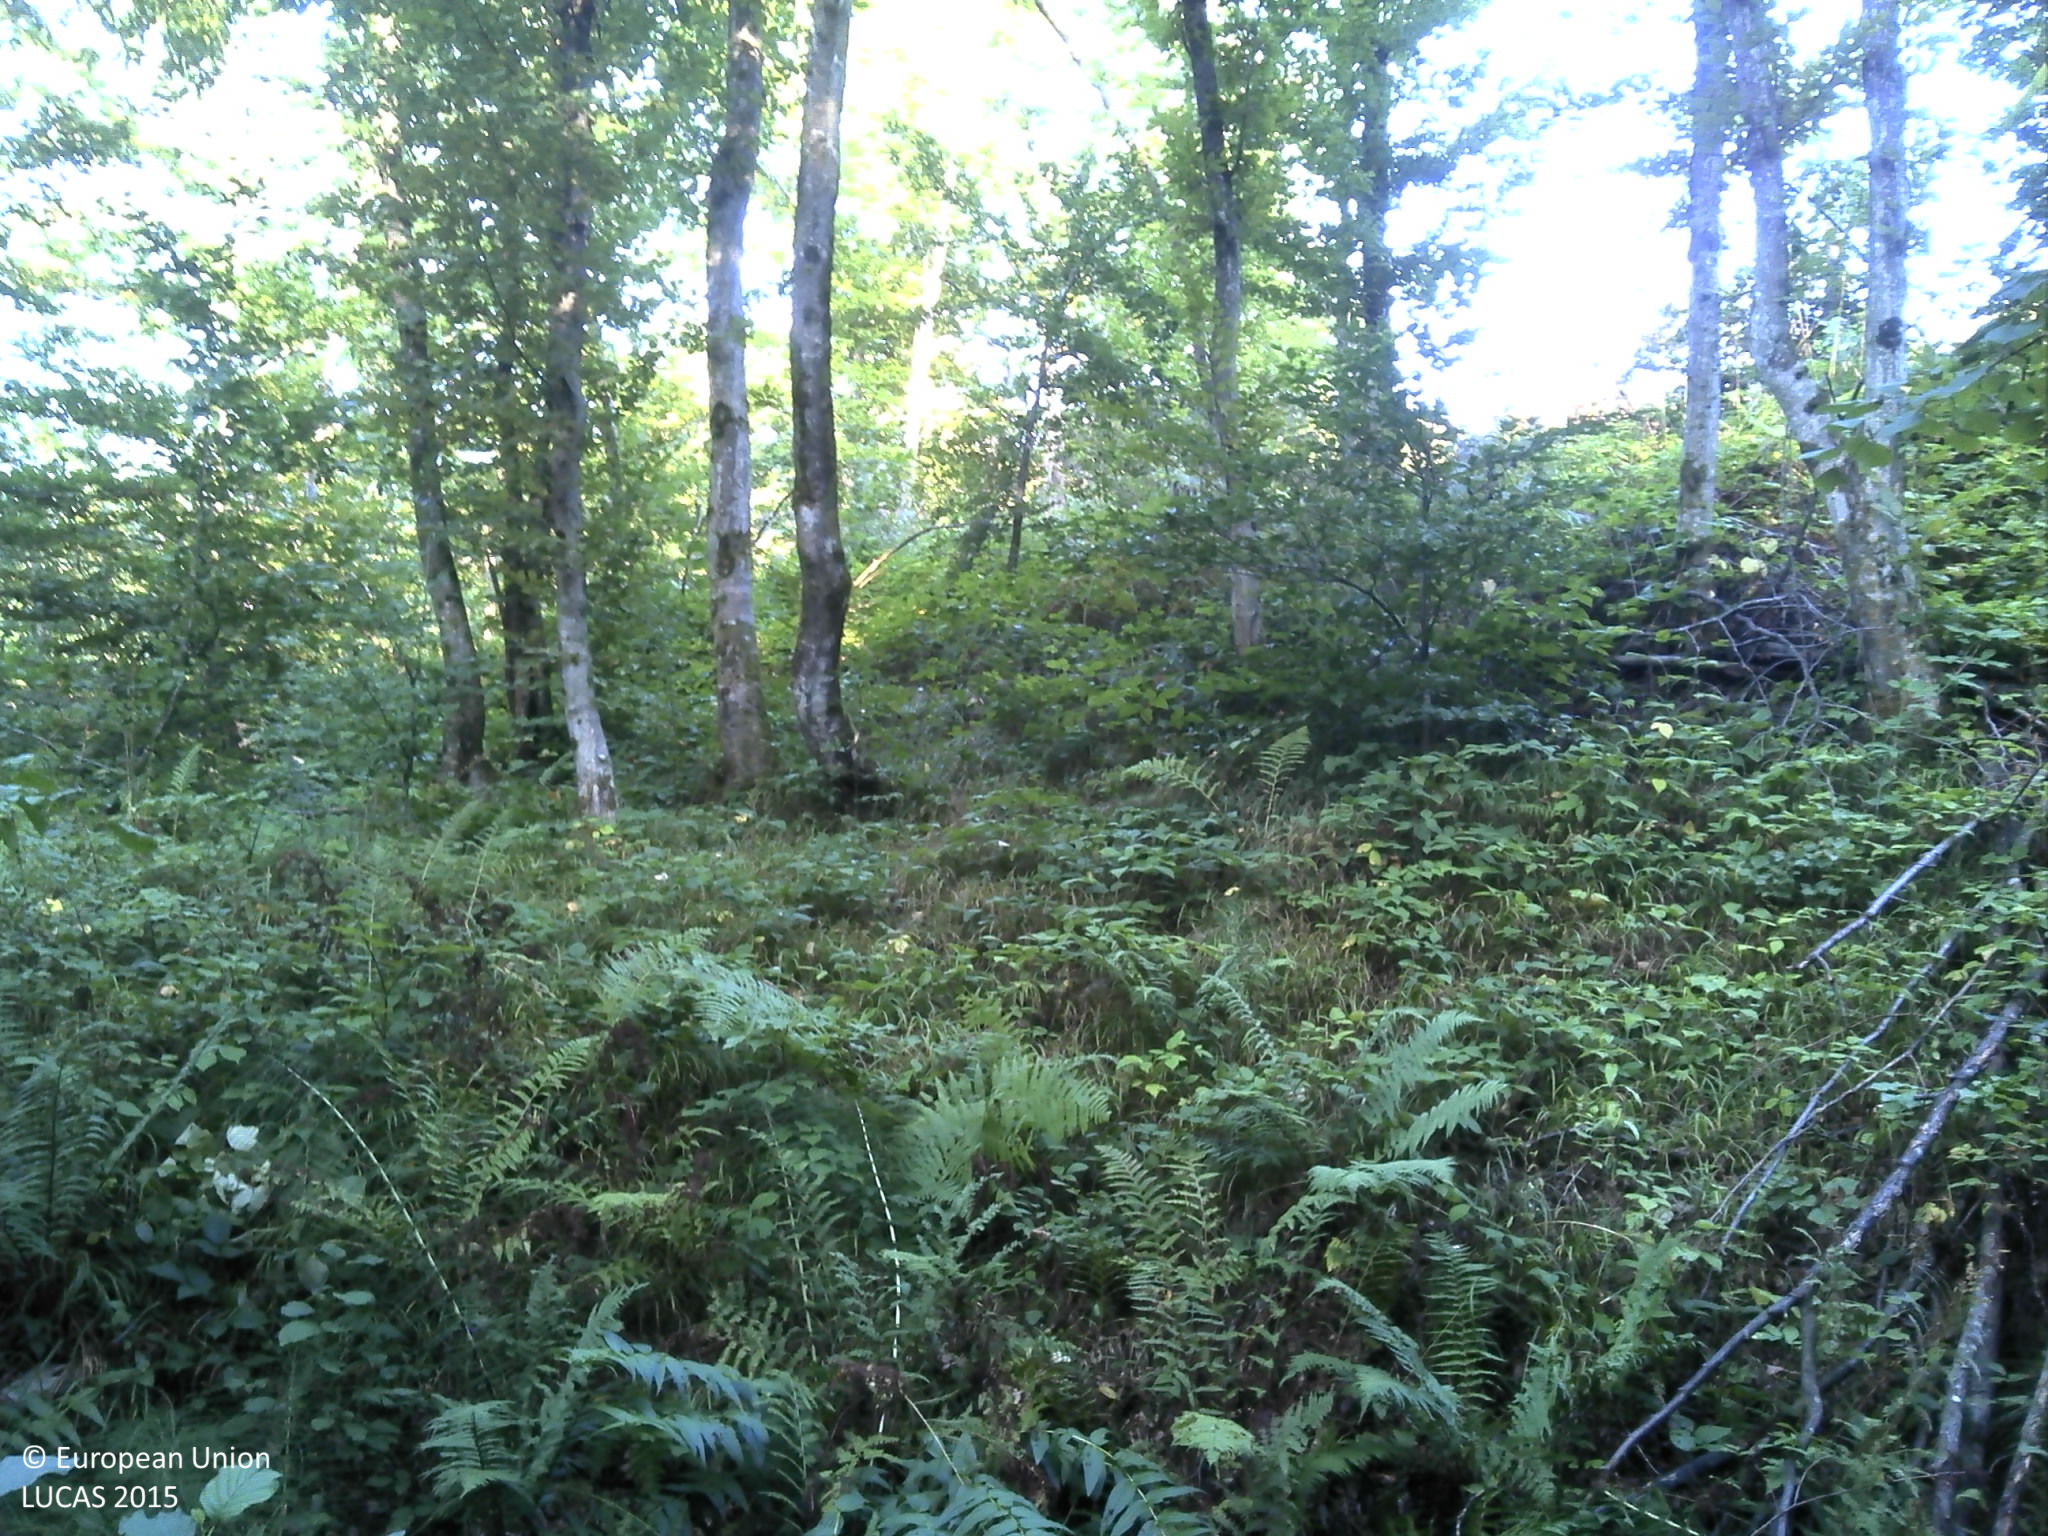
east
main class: Woodland
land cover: Broadleaved woodland
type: beech forest
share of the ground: > 75 %
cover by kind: broadleaved forest trees 100 %
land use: Forestry
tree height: > 5 m
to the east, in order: Broadleaved woodland; Rivers and streams; Broadleaved woodland
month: August
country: HR
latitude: 45.3031
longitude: 16.5145
